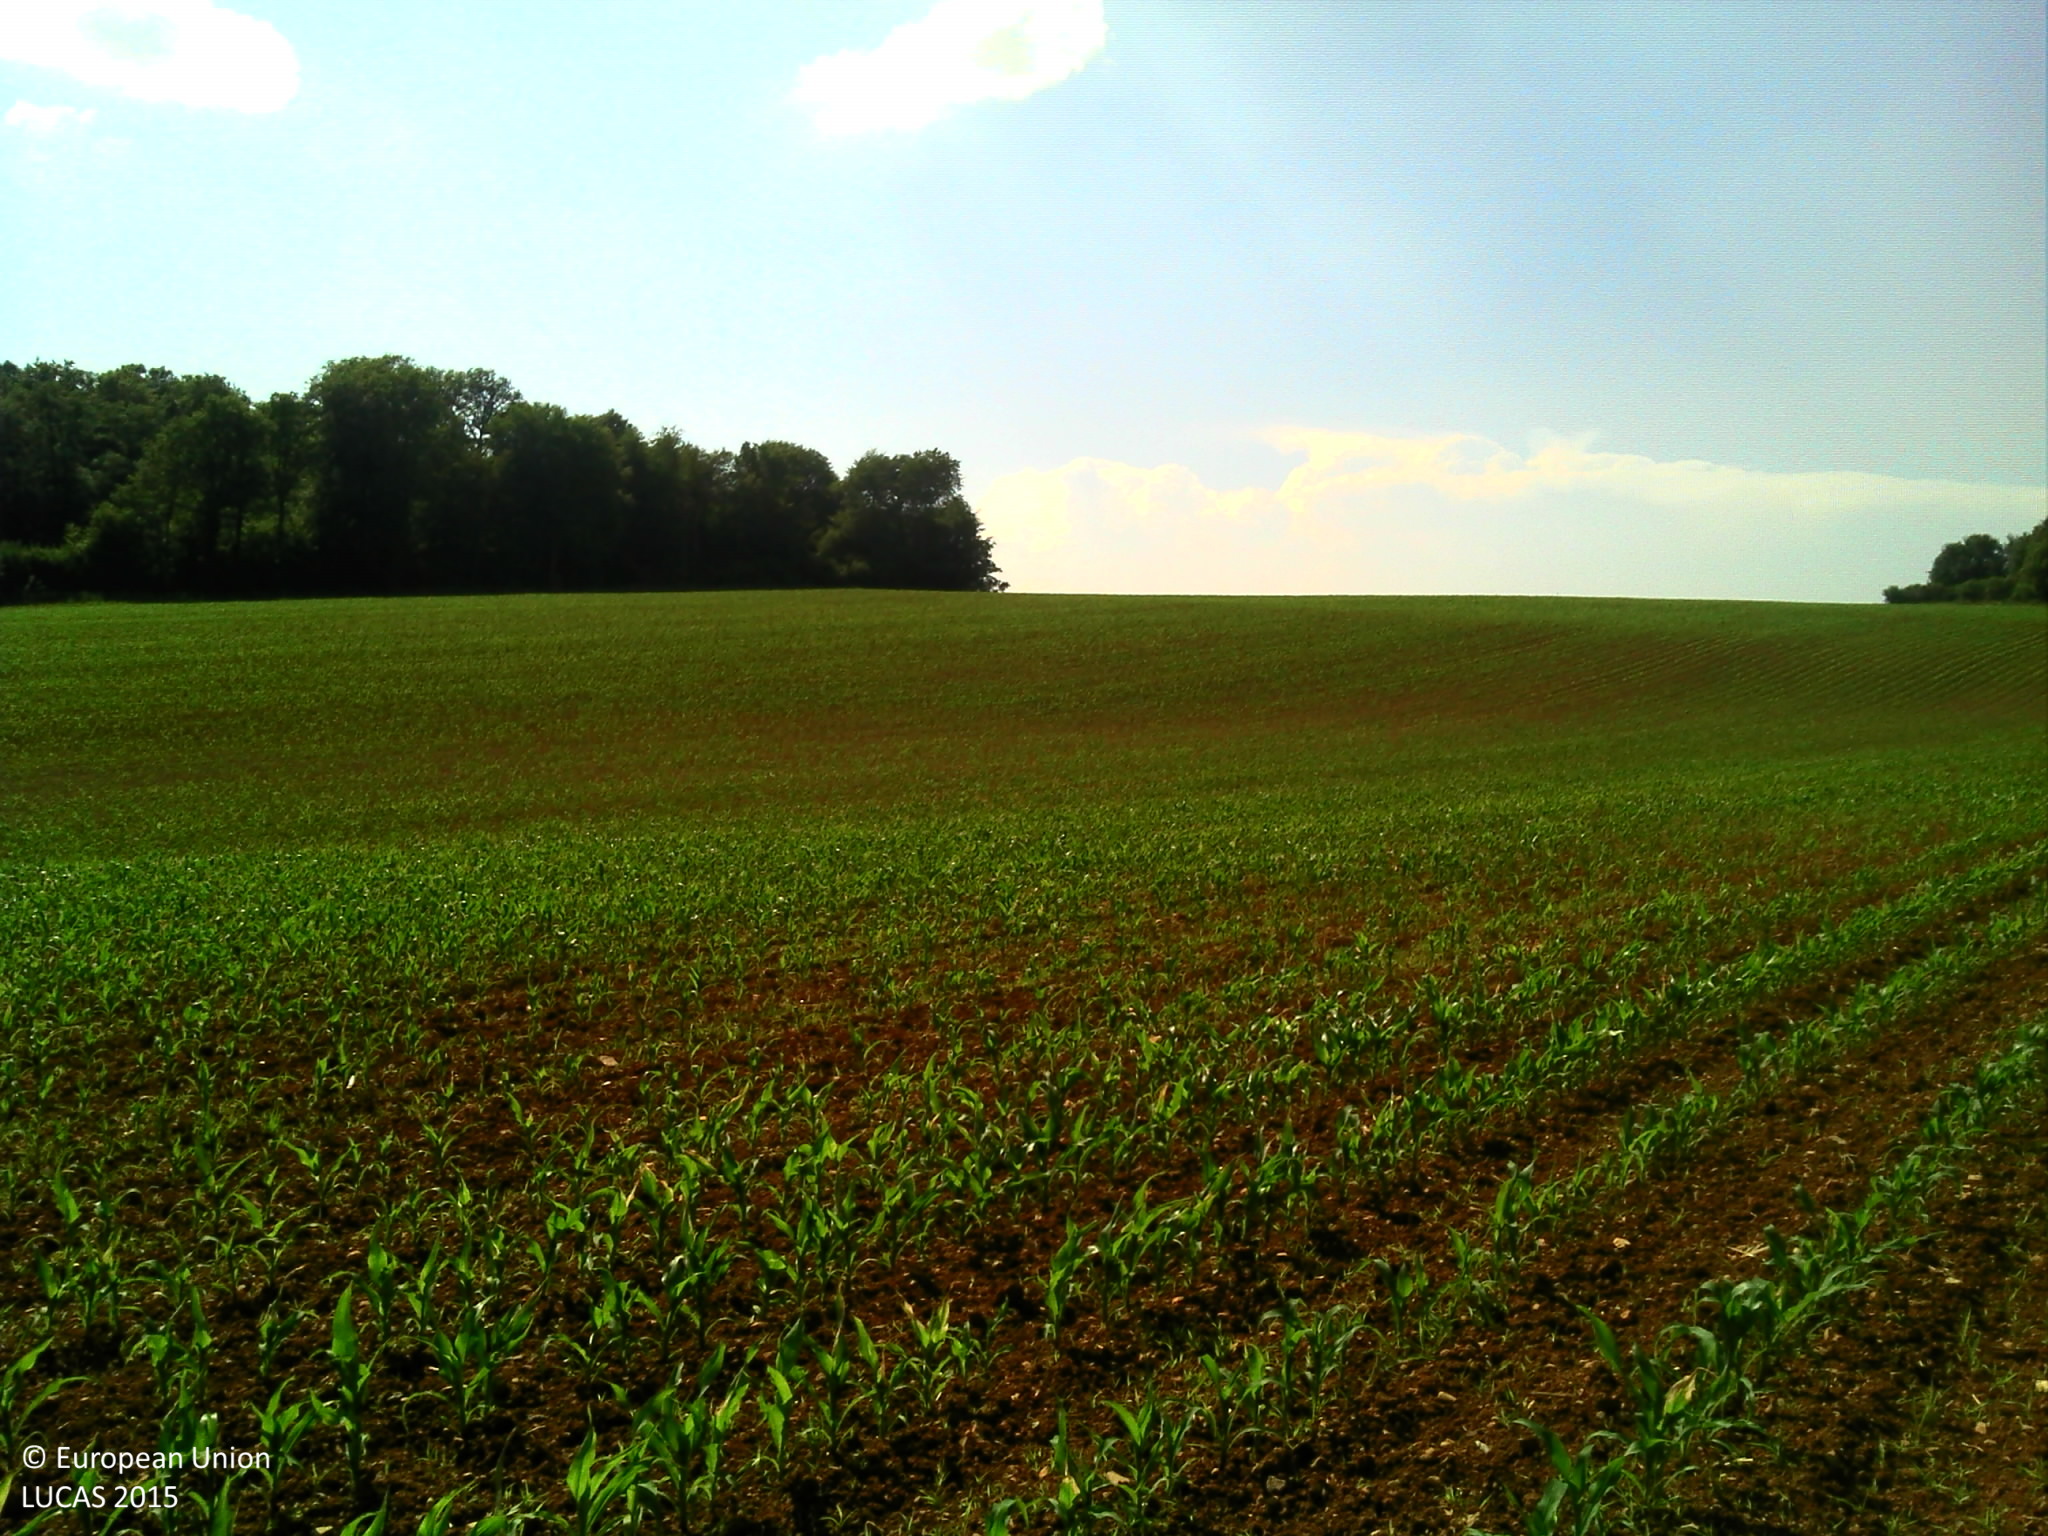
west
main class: Cropland
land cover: Maize
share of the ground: 25 - 50 %
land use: Agriculture (excluding fallow land and kitchen gardens)
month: June
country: FR
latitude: 47.6386
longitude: 6.2878
